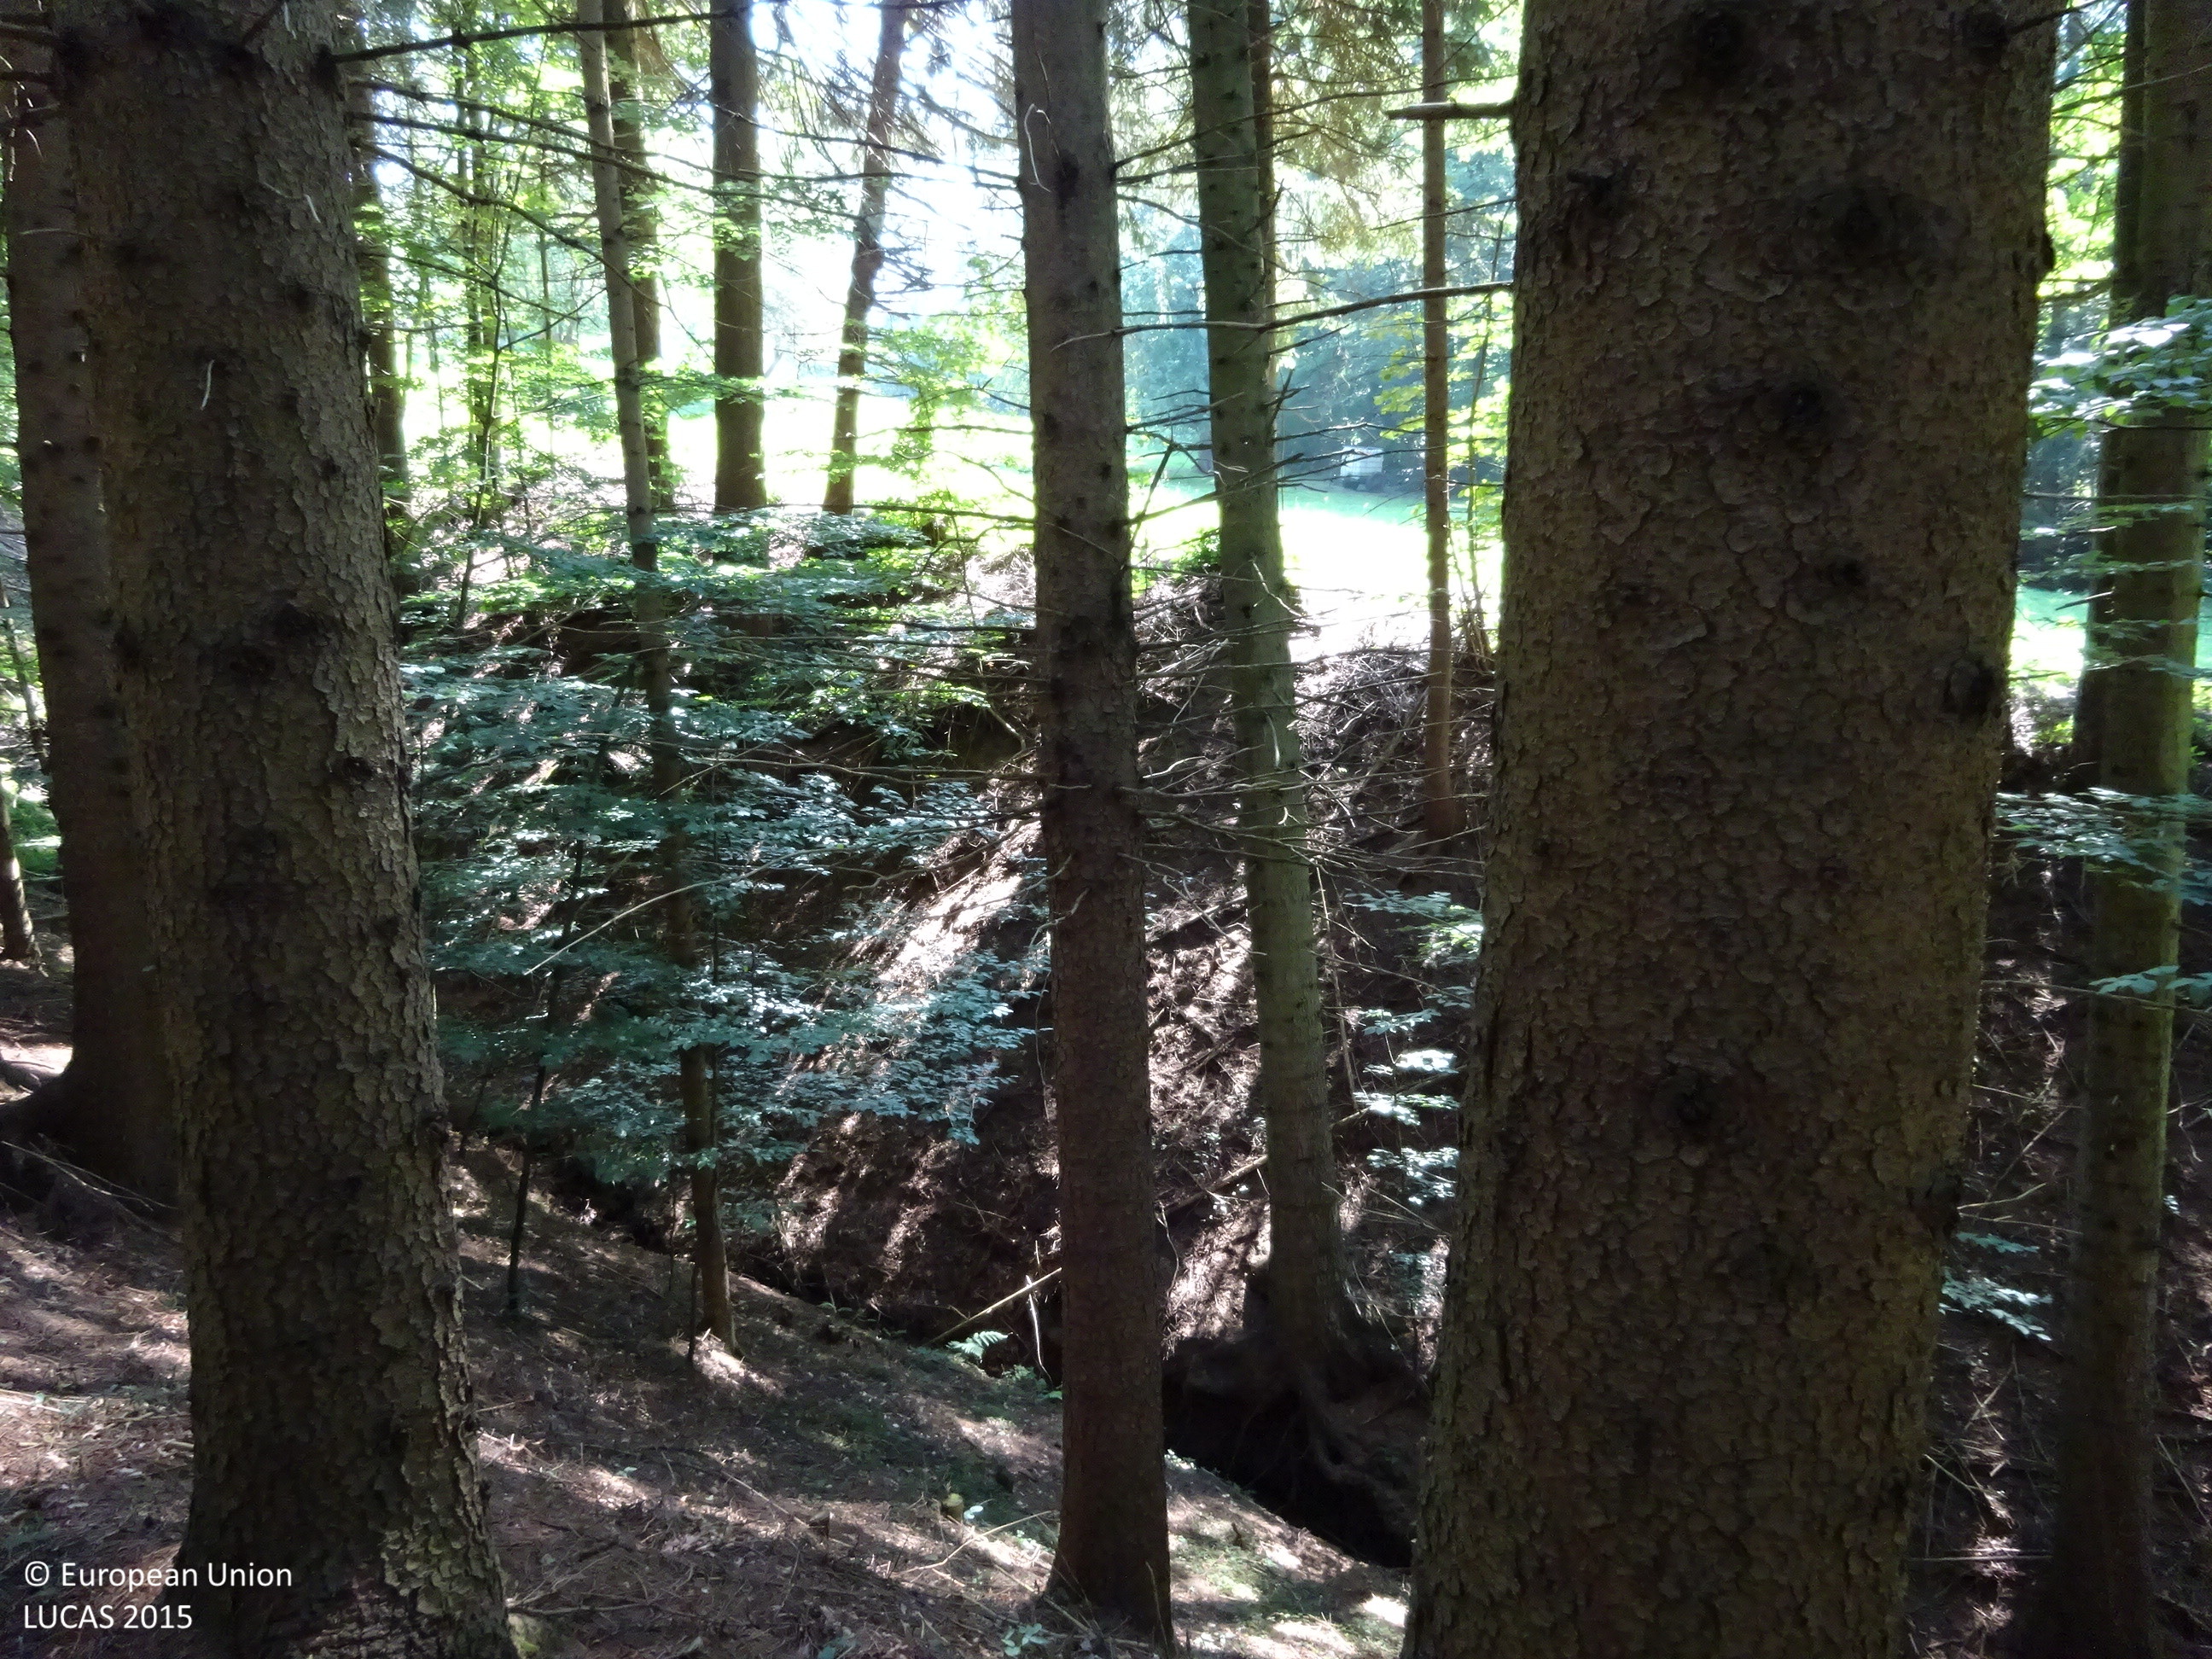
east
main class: Woodland
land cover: Spruce dominated coniferous woodland
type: alpine coniferous forest
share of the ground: > 75 %
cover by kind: coniferous forest trees 95 %, broadleaved forest trees 5 %
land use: Forestry
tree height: > 5 m
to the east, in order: Spruce dominated coniferous woodland; Rivers and streams; Spruce dominated coniferous woodland; Fences; Grassland without tree/shrub cover; Apple fruit; Fences; Grassland without tree/shrub cover; Other fruit trees and berries; Fences; Artificial constructions in urban areas; Other fruit trees and berries; Nuts trees; Grassland without tree/shrub cover; Fences; Other fresh vegetables; Fences; Tracks; Grassland without tree/shrub cover
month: August
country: AT
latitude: 47.4596
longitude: 16.0910
